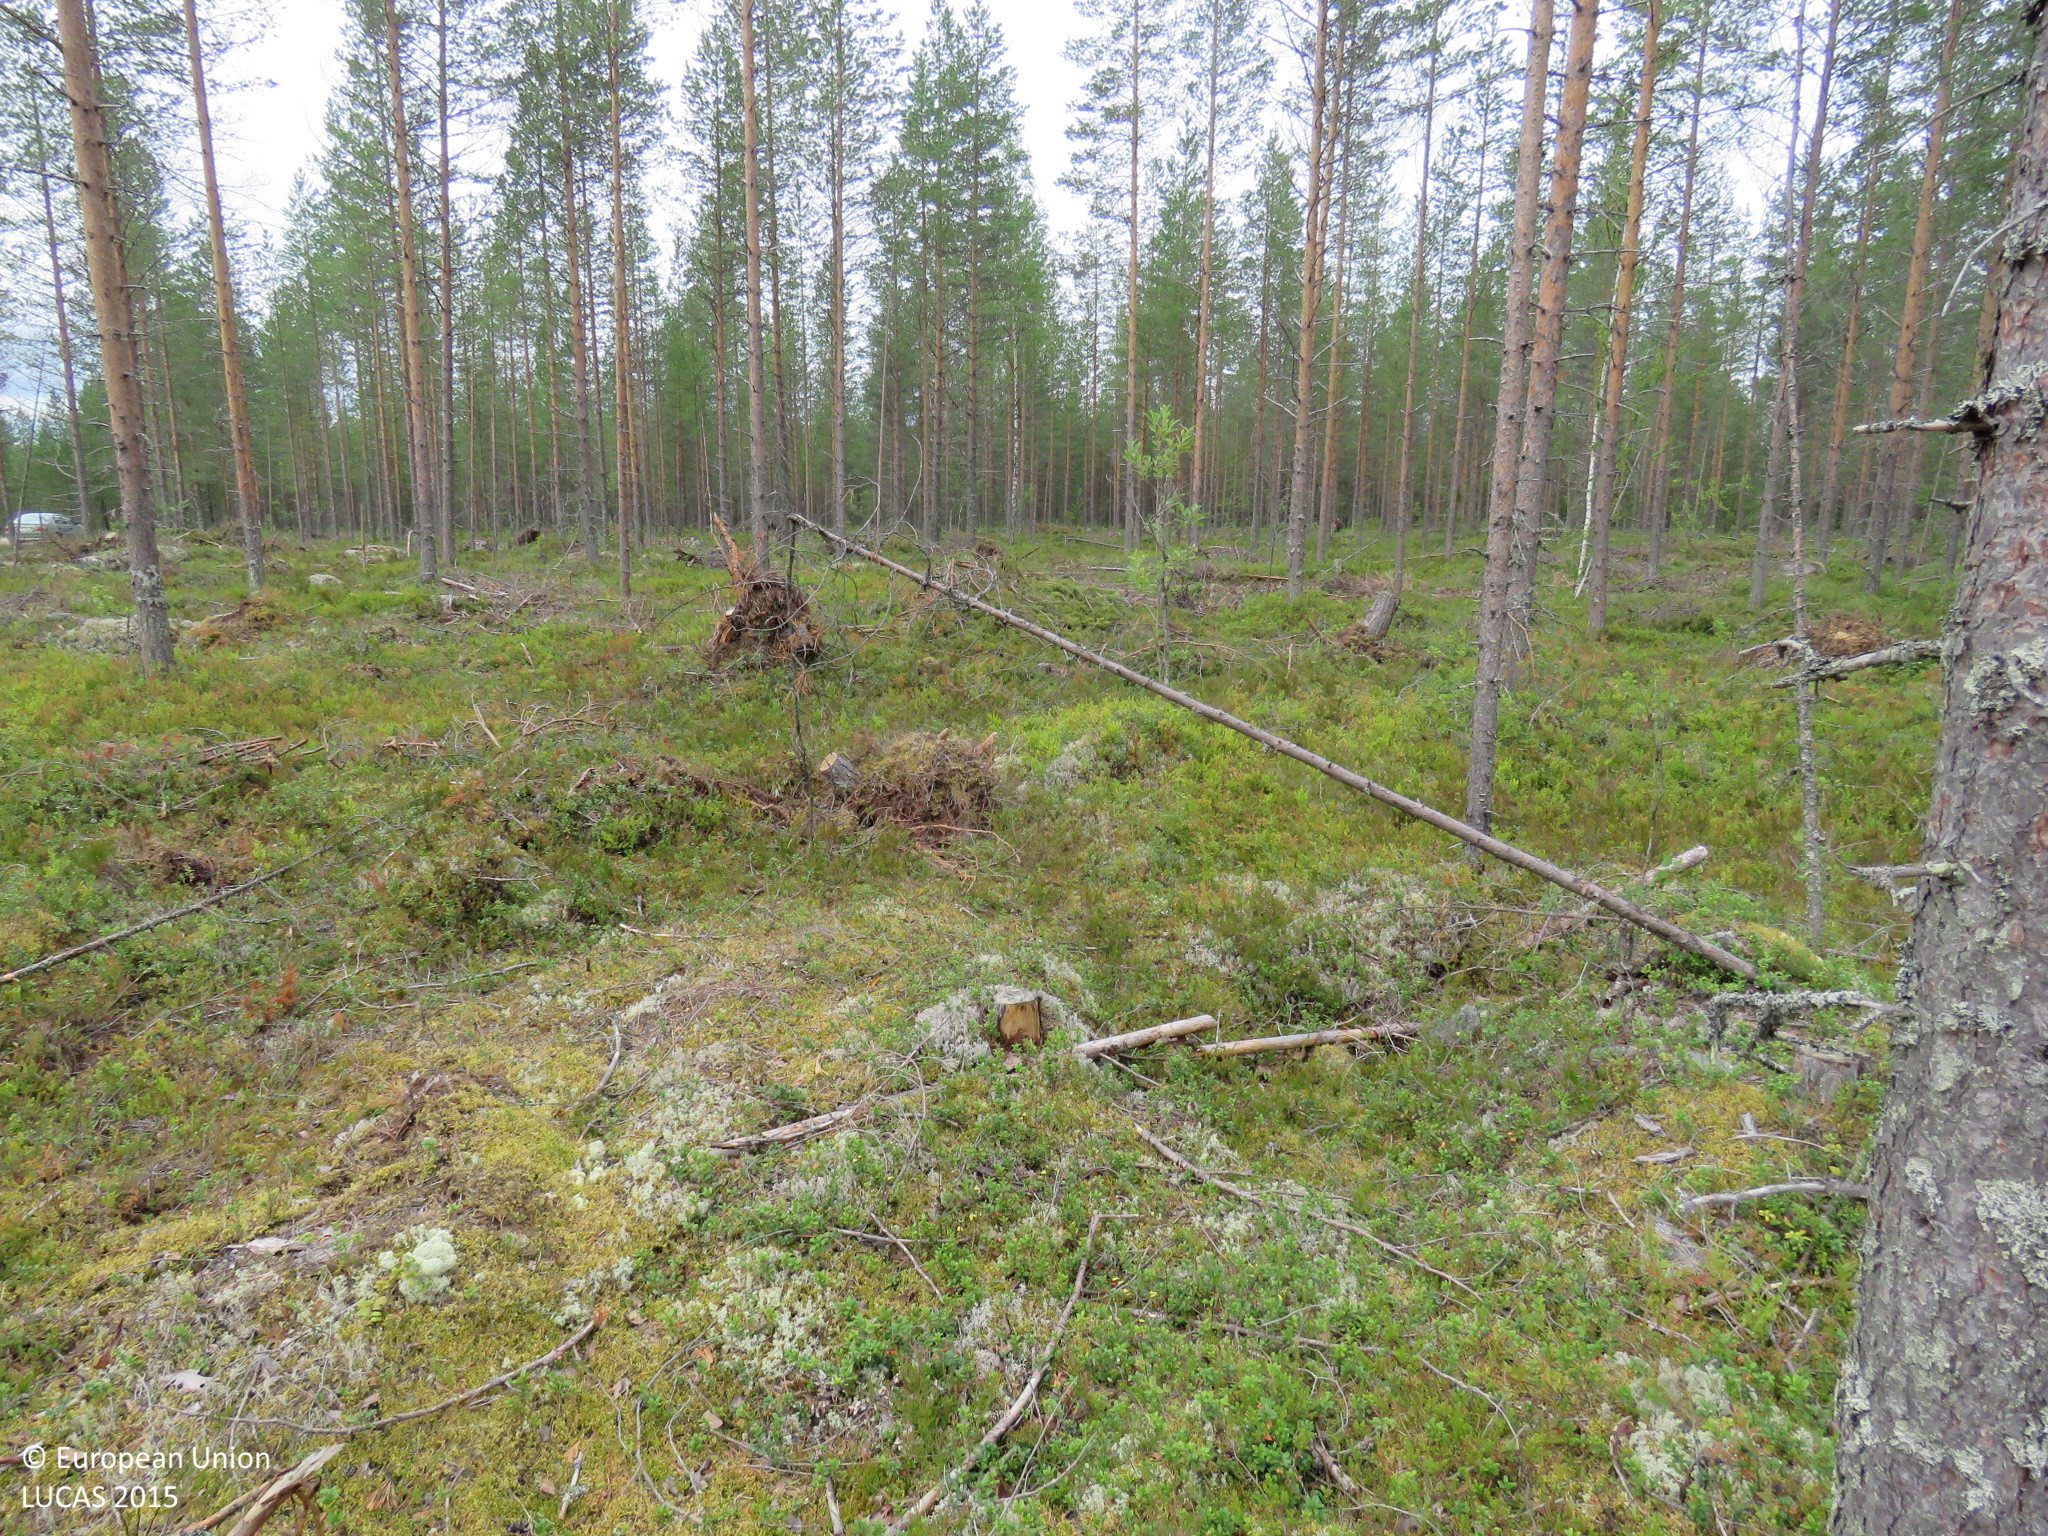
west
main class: Woodland
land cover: Pine dominated coniferous woodland
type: boreal forest
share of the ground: 50 - 75 %
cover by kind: coniferous forest trees 40 %, shrubs 40 %, broadleaved forest trees 10 %, lichens and mosses 10 %
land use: Forestry
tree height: > 5 m
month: July
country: FI
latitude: 64.6479
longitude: 26.9326
